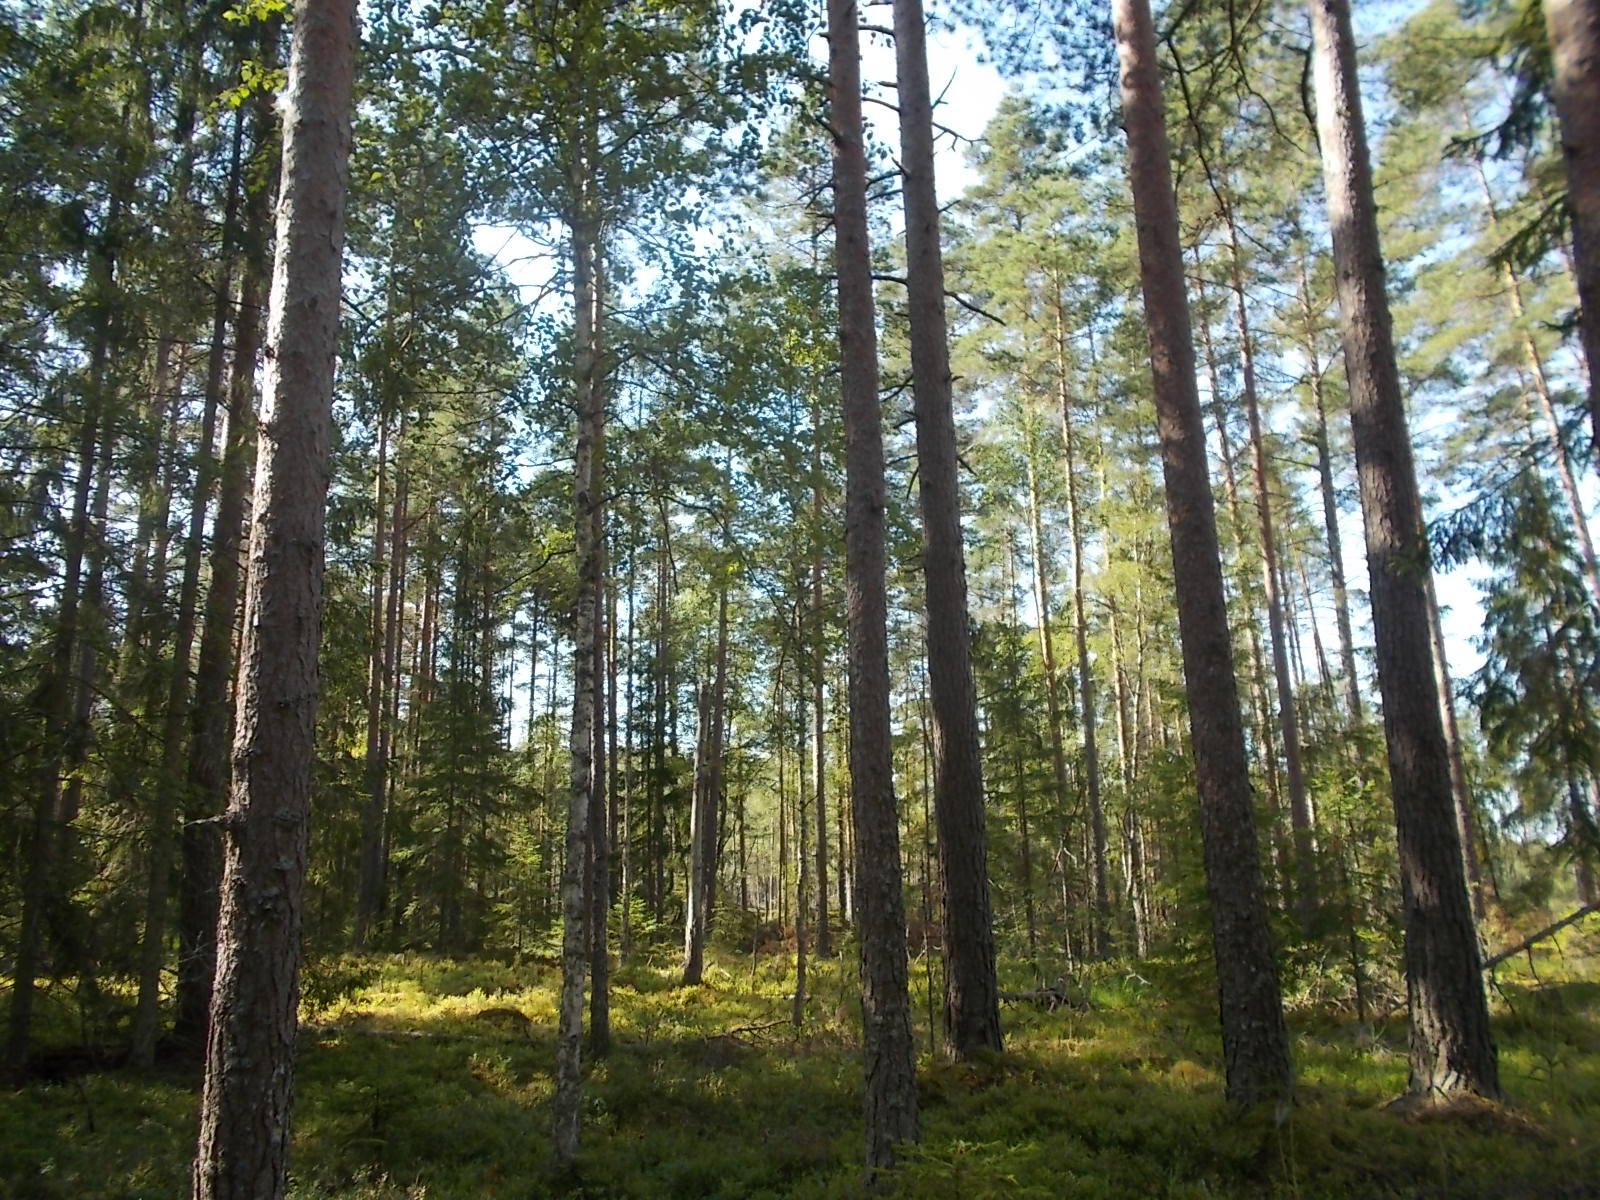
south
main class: Woodland
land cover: Other coniferous woodland
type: hemiboreal forest and nemoral coniferous forest and mixed broadleaved-coniferous forest
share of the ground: 50 - 75 %
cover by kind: coniferous forest trees 60 %, broadleaved forest trees 10 %, shrubs 10 %, herbaceous plants 10 %, lichens and mosses 10 %
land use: Forestry
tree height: > 5 m
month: August
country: LV
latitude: 57.0631
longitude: 21.9693
